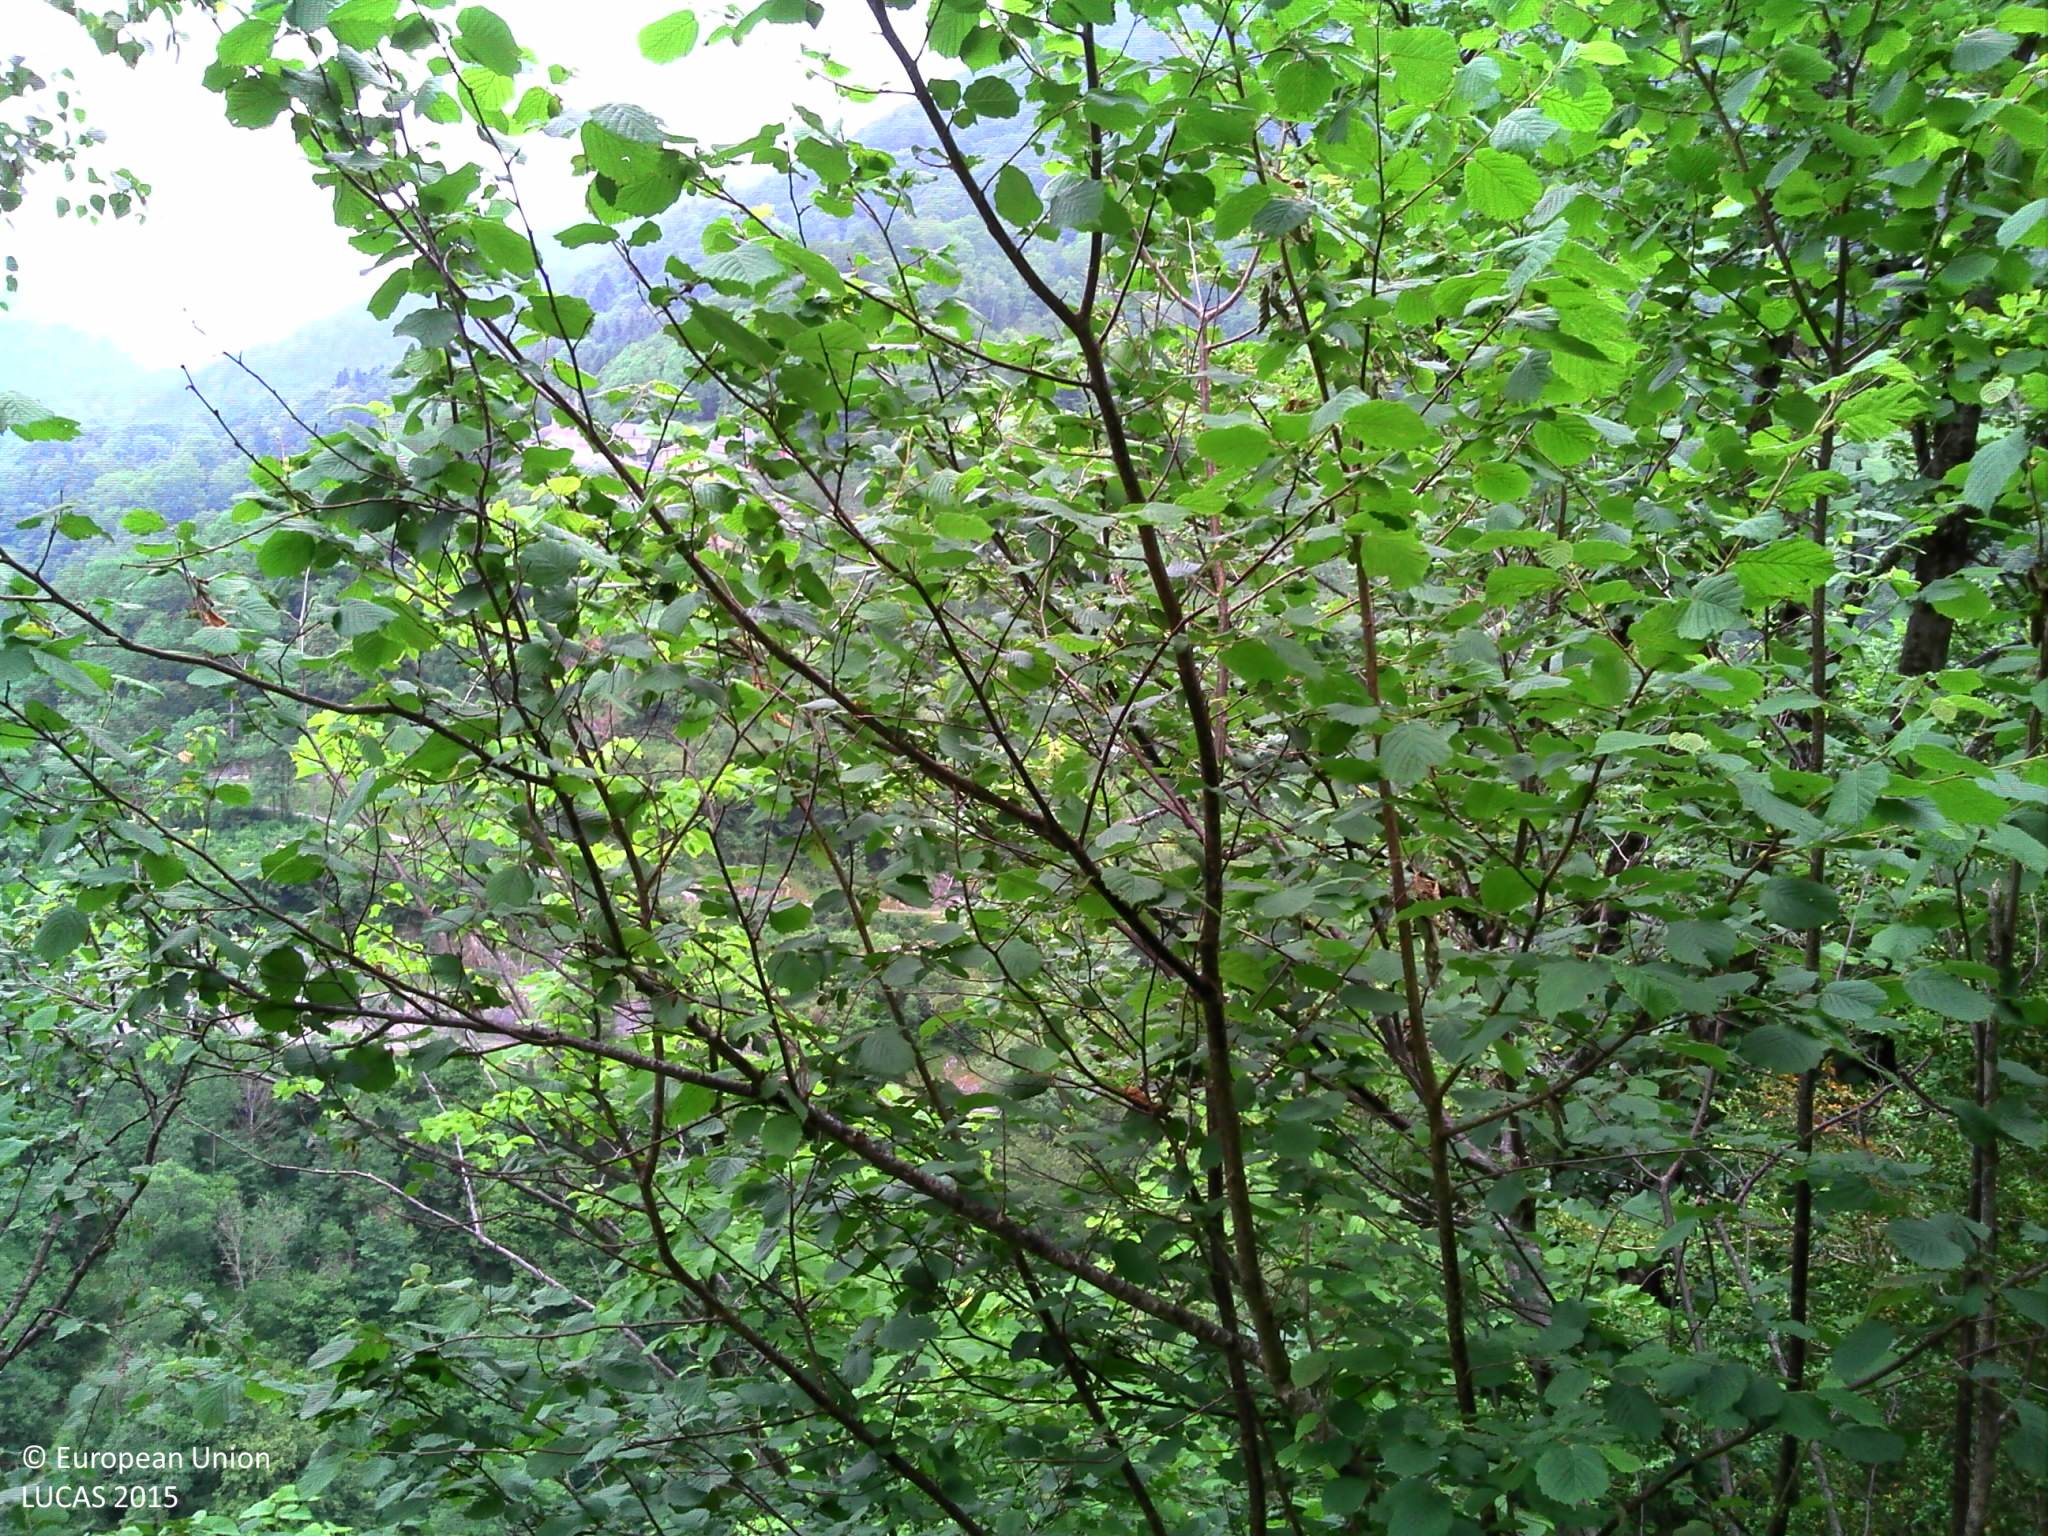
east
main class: Woodland
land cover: Broadleaved woodland
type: mountainous beech forest
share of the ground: > 75 %
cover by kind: broadleaved forest trees 50 %, shrubs 30 %, herbaceous plants 10 %, consolidated bare surface 10 %
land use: Semi-natural and natural areas not in use
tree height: > 5 m
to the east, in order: Broadleaved woodland; Inland fresh running water; Broadleaved woodland; Grass margins; Fences; Paved roads, cycling and walking lanes; Rock outcrops; Broadleaved woodland; Electric lines; Grass margins
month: July
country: FR
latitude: 42.9249
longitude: 0.8023
